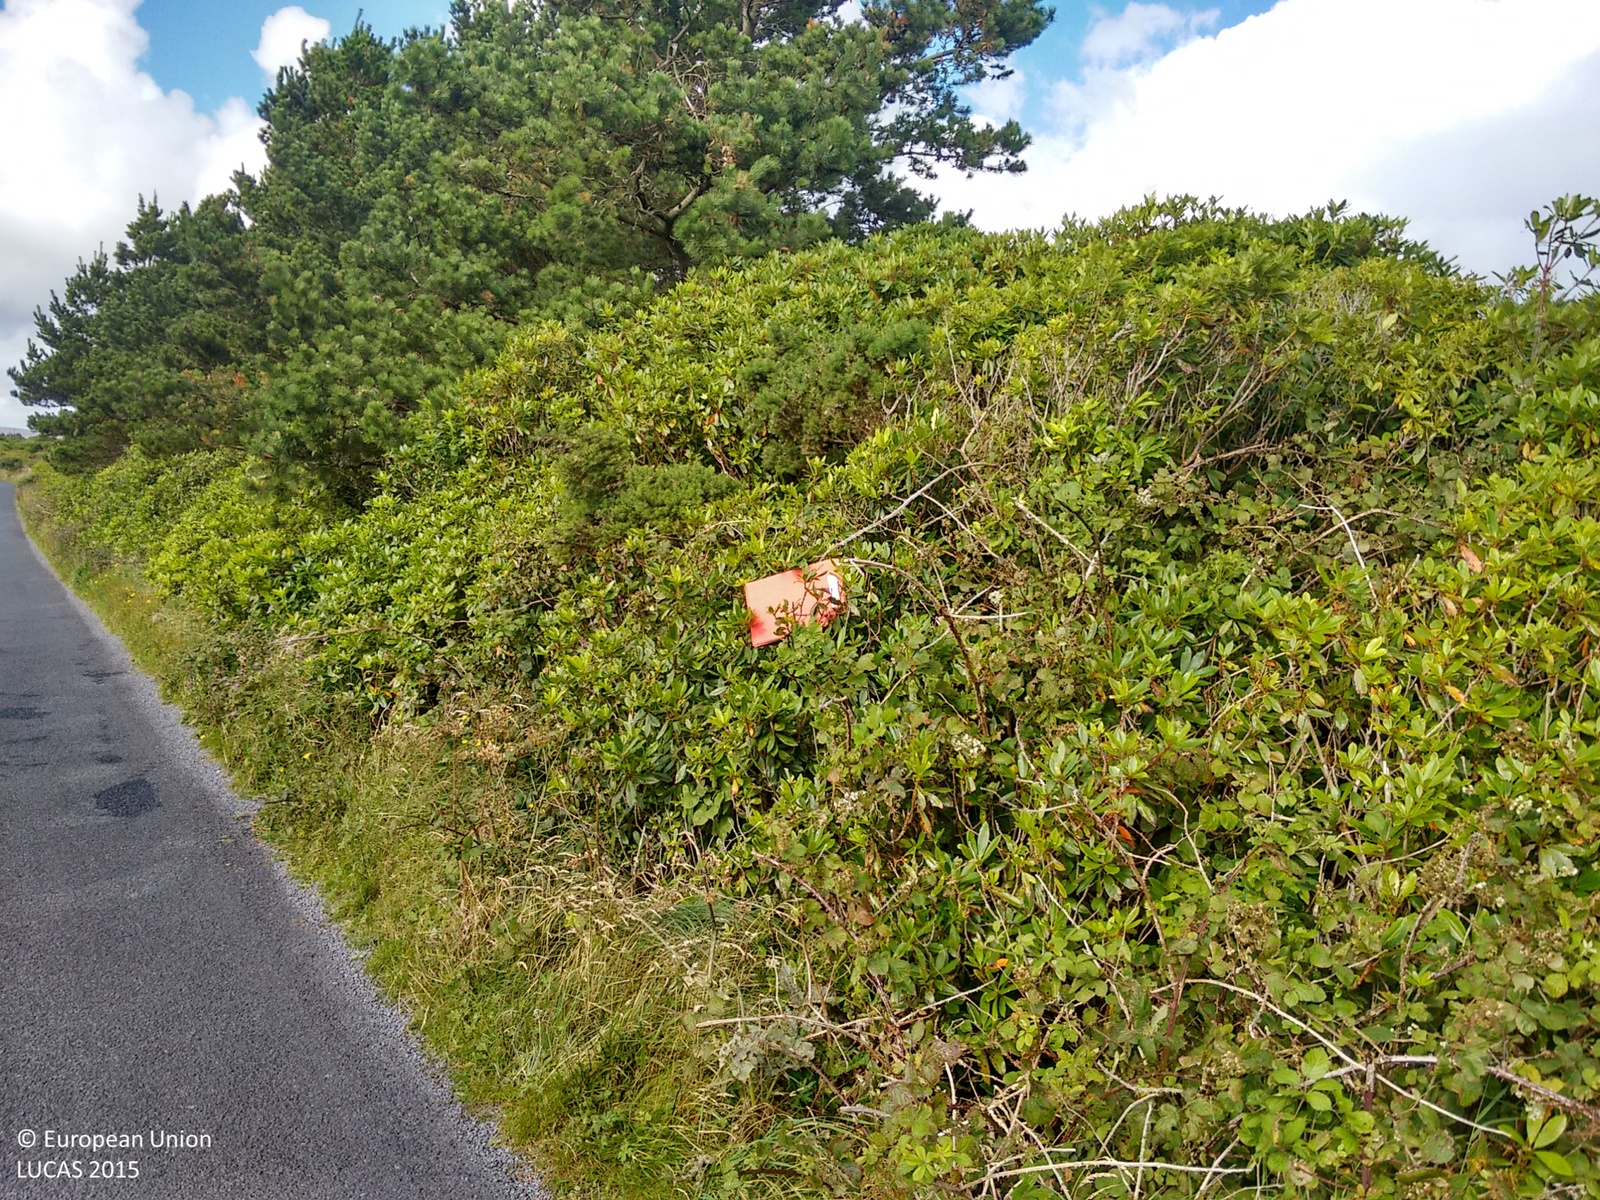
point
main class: Shrubland
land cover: Shrubland with sparse tree cover
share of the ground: 50 - 75 %
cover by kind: shrubs 35 %, herbaceous plants 20 %, lichens and mosses 20 %, consolidated bare surface 20 %, coniferous forest trees 5 %
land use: Semi-natural and natural areas not in use
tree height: > 5 m
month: August
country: IE
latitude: 54.0201
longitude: -9.8280
